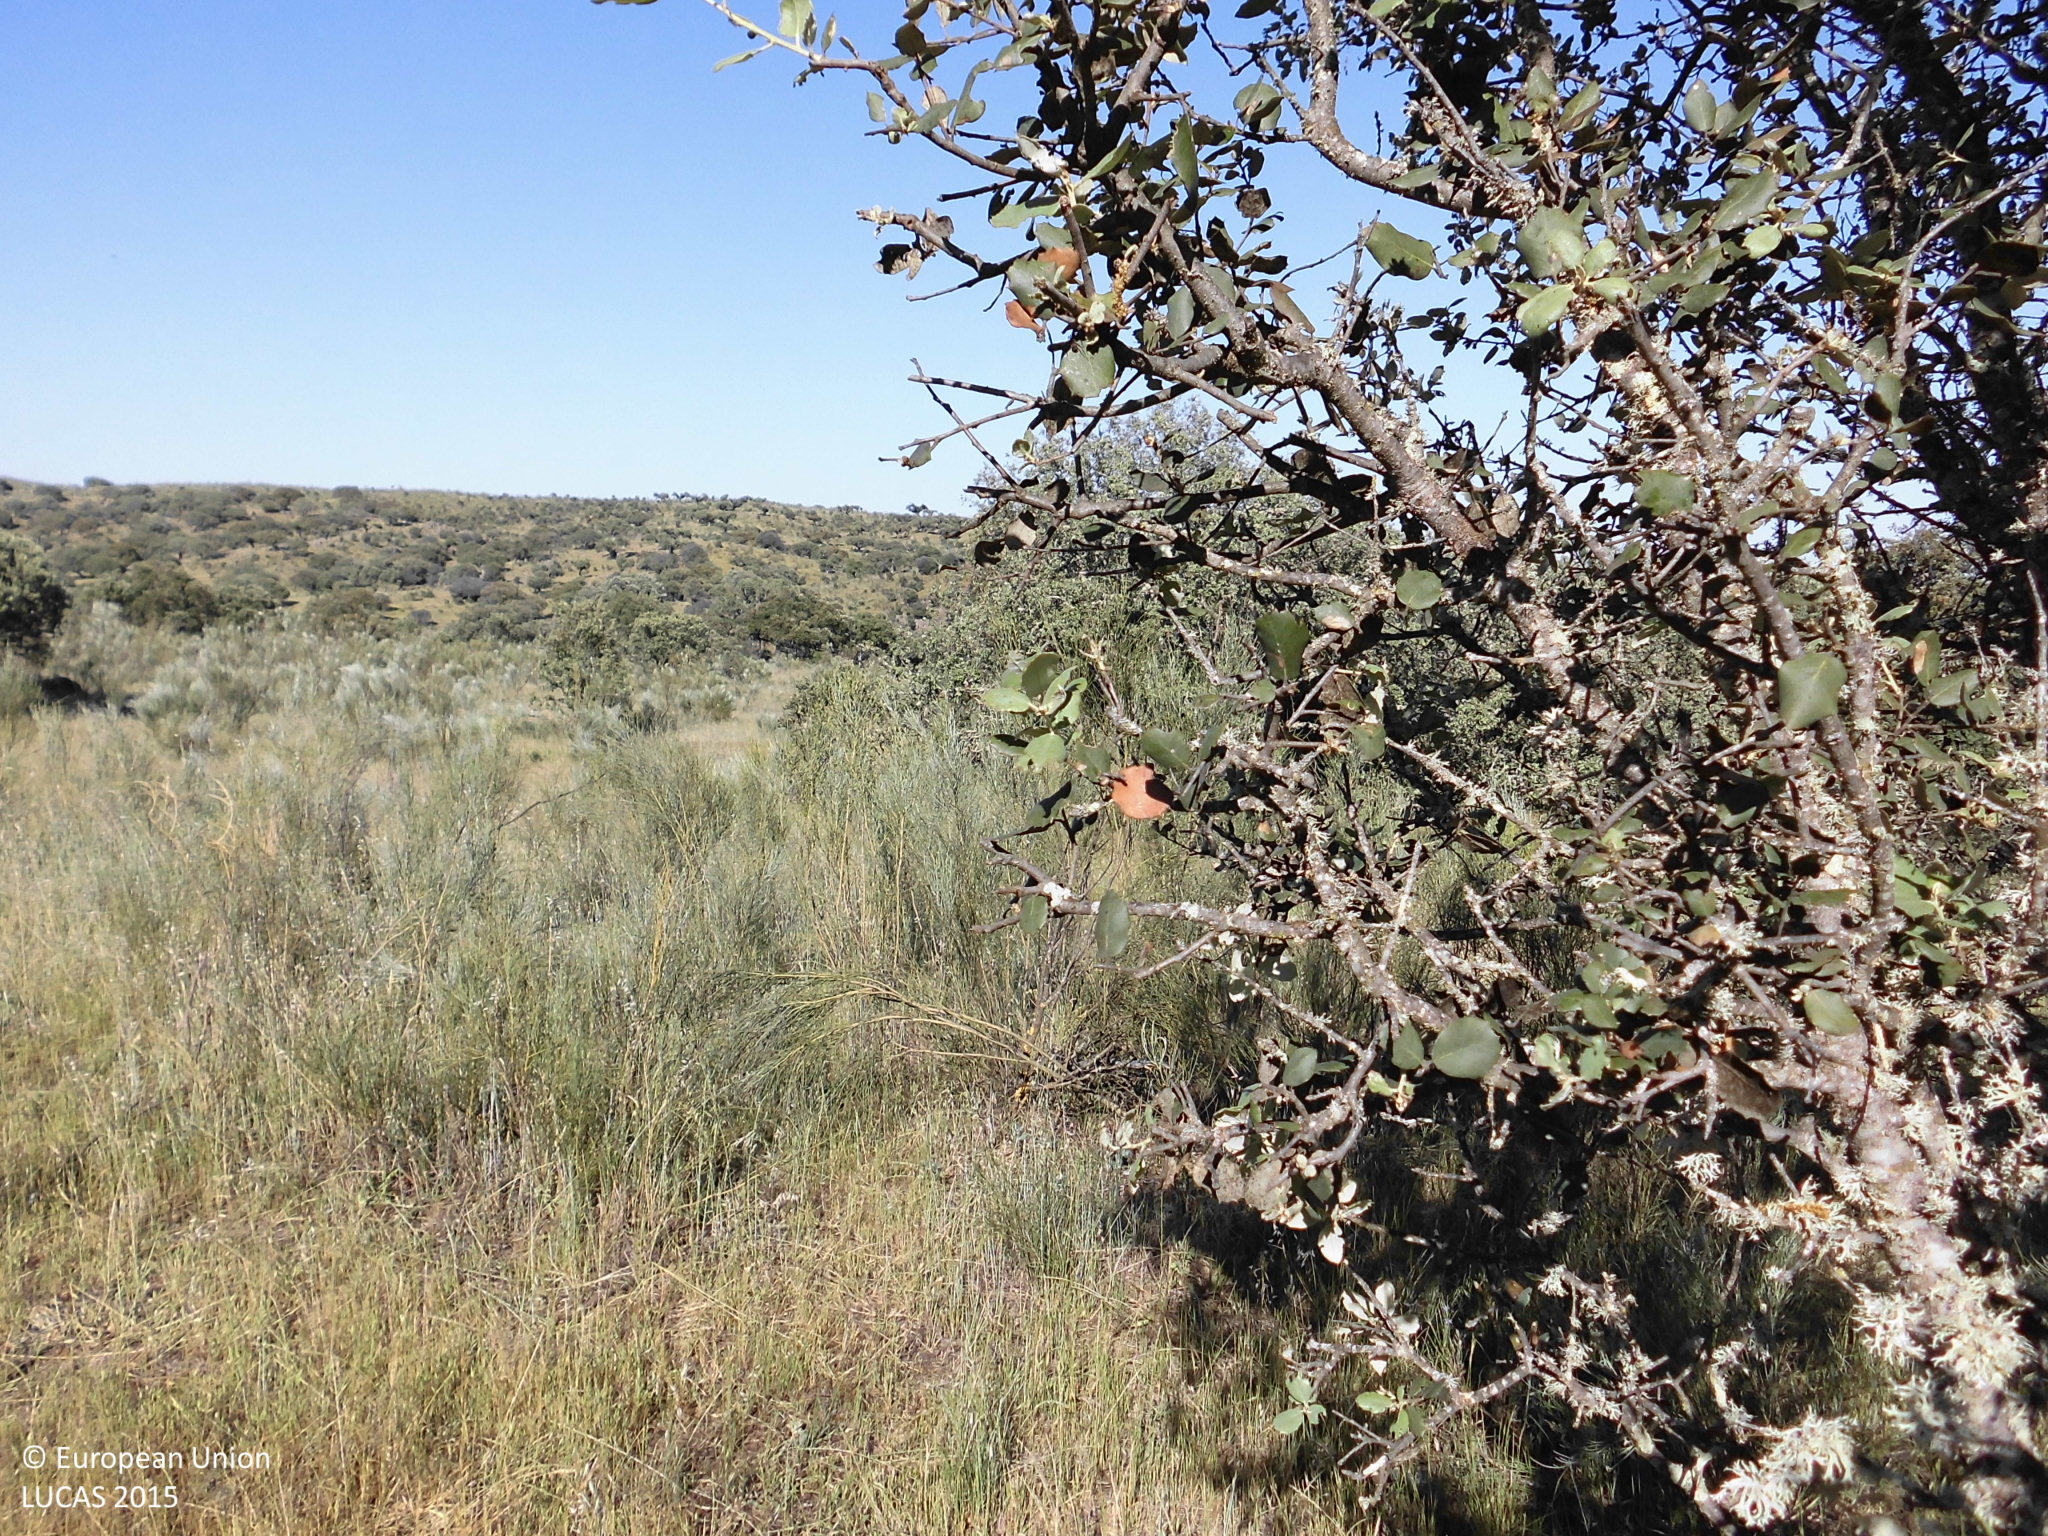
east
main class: Woodland
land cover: Broadleaved woodland
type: broadleaved evergreen forest
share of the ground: 25 - 50 %
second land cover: Grassland without tree/shrub cover
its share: > 75 %
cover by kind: herbaceous plants 55 %, broadleaved forest trees 40 %, shrubs 5 %
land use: Forestry
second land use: Agriculture (excluding fallow land and kitchen gardens)
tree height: > 5 m
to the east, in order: Broadleaved woodland; Grassland without tree/shrub cover; Grassland with sparse tree/shrub cover; Broadleaved woodland
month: May
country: ES
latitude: 39.5201
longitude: -6.0806
